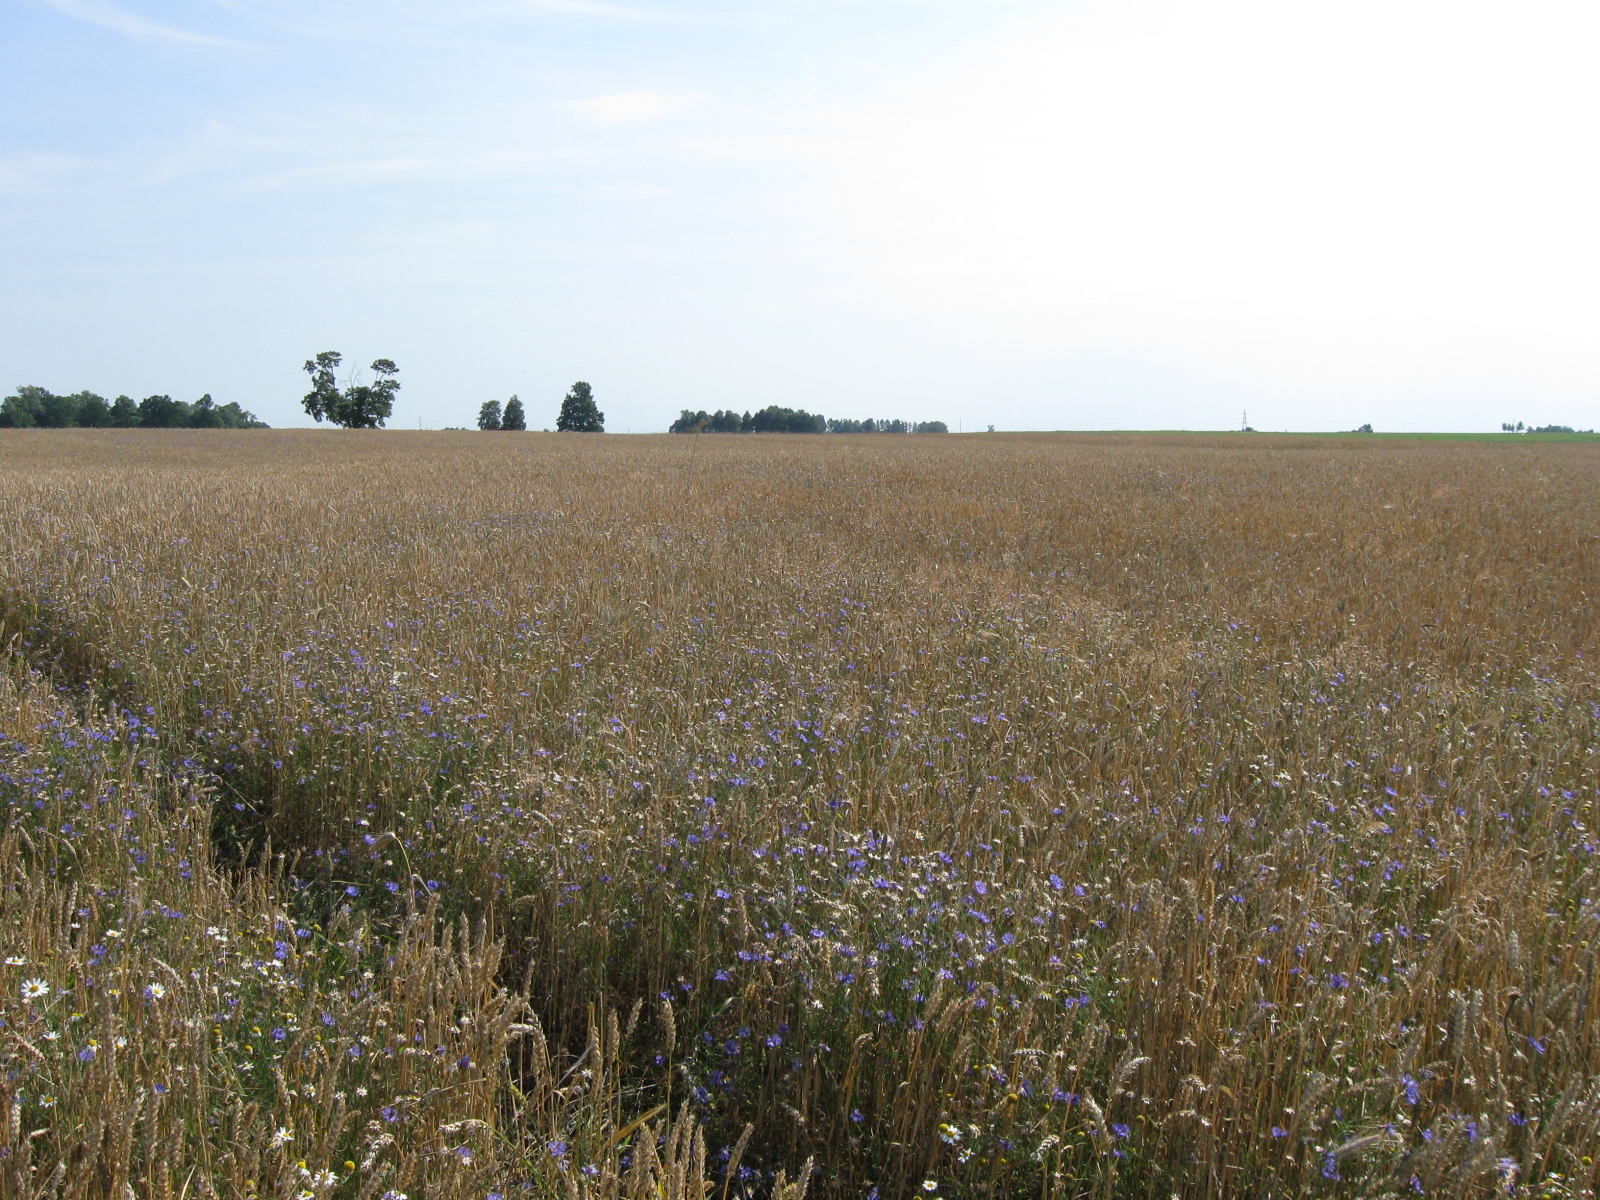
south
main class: Cropland
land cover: Common wheat
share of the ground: > 75 %
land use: Agriculture (excluding fallow land and kitchen gardens)
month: July
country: LT
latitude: 54.5802
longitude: 23.6219
